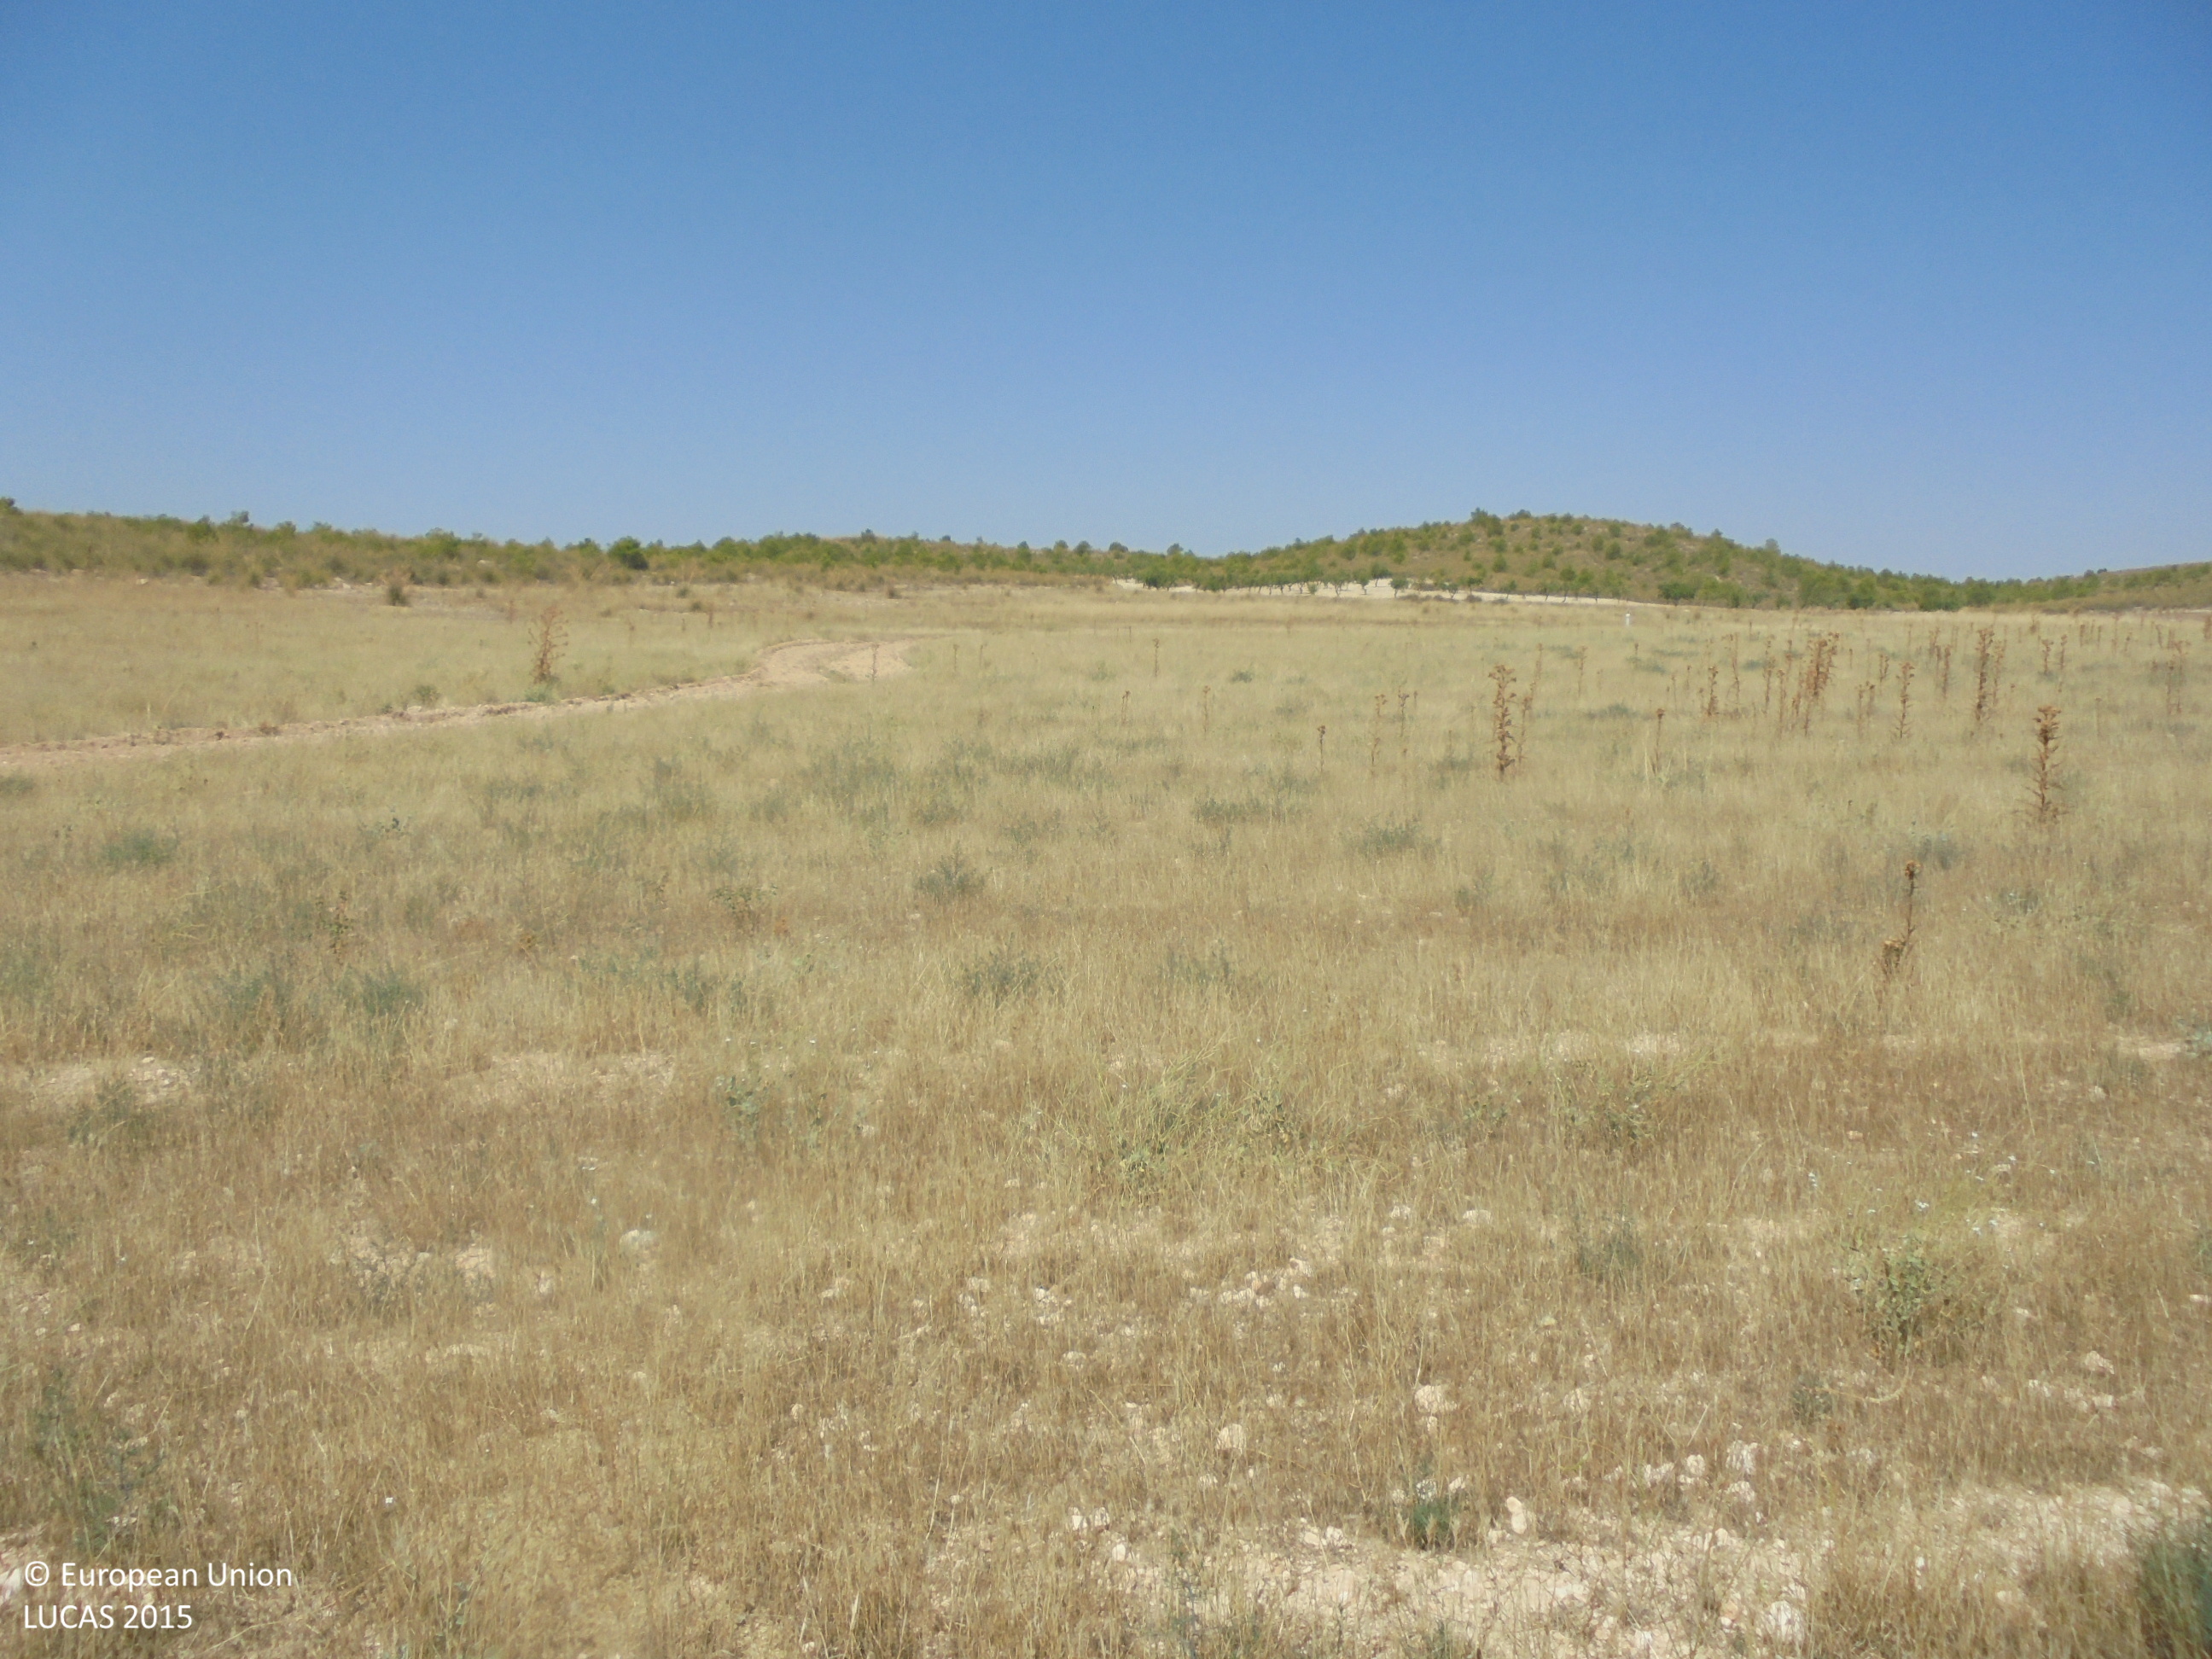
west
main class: Grassland
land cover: Spontaneously vegetated surfaces
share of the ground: > 75 %
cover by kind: herbaceous plants 80 %, unconsolidated bare surface 20 %
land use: Fallow land
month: July
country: ES
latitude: 38.5597
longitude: -1.5492
